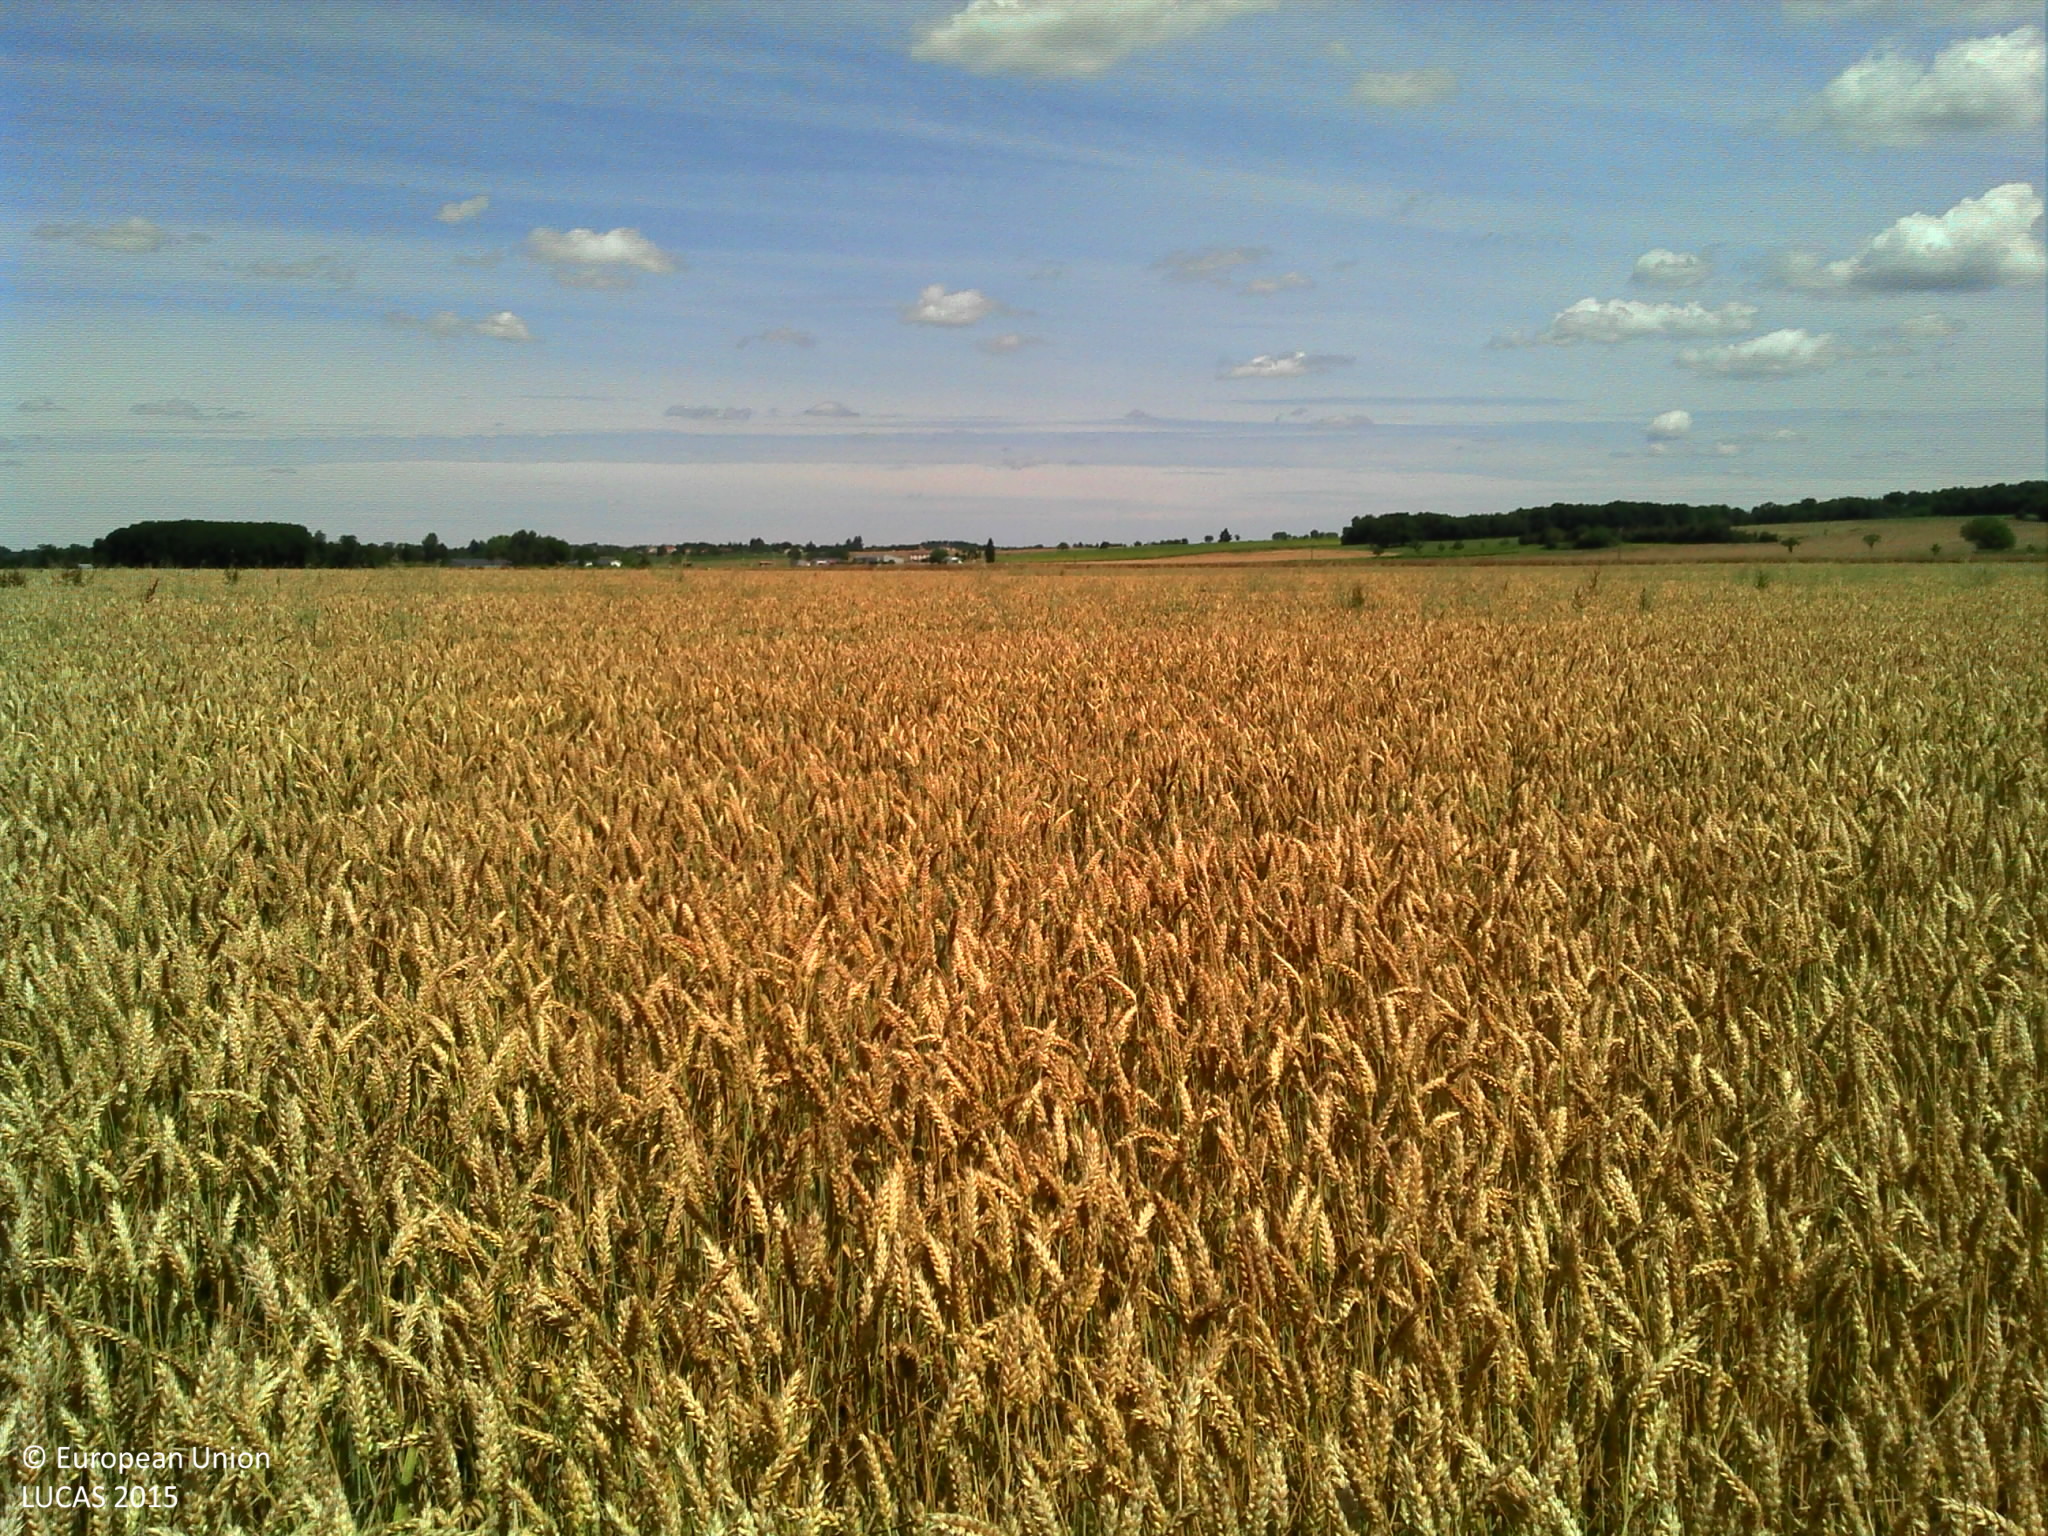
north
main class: Cropland
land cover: Common wheat
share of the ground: > 75 %
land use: Agriculture (excluding fallow land and kitchen gardens)
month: June
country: FR
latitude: 45.7692
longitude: 0.3532
